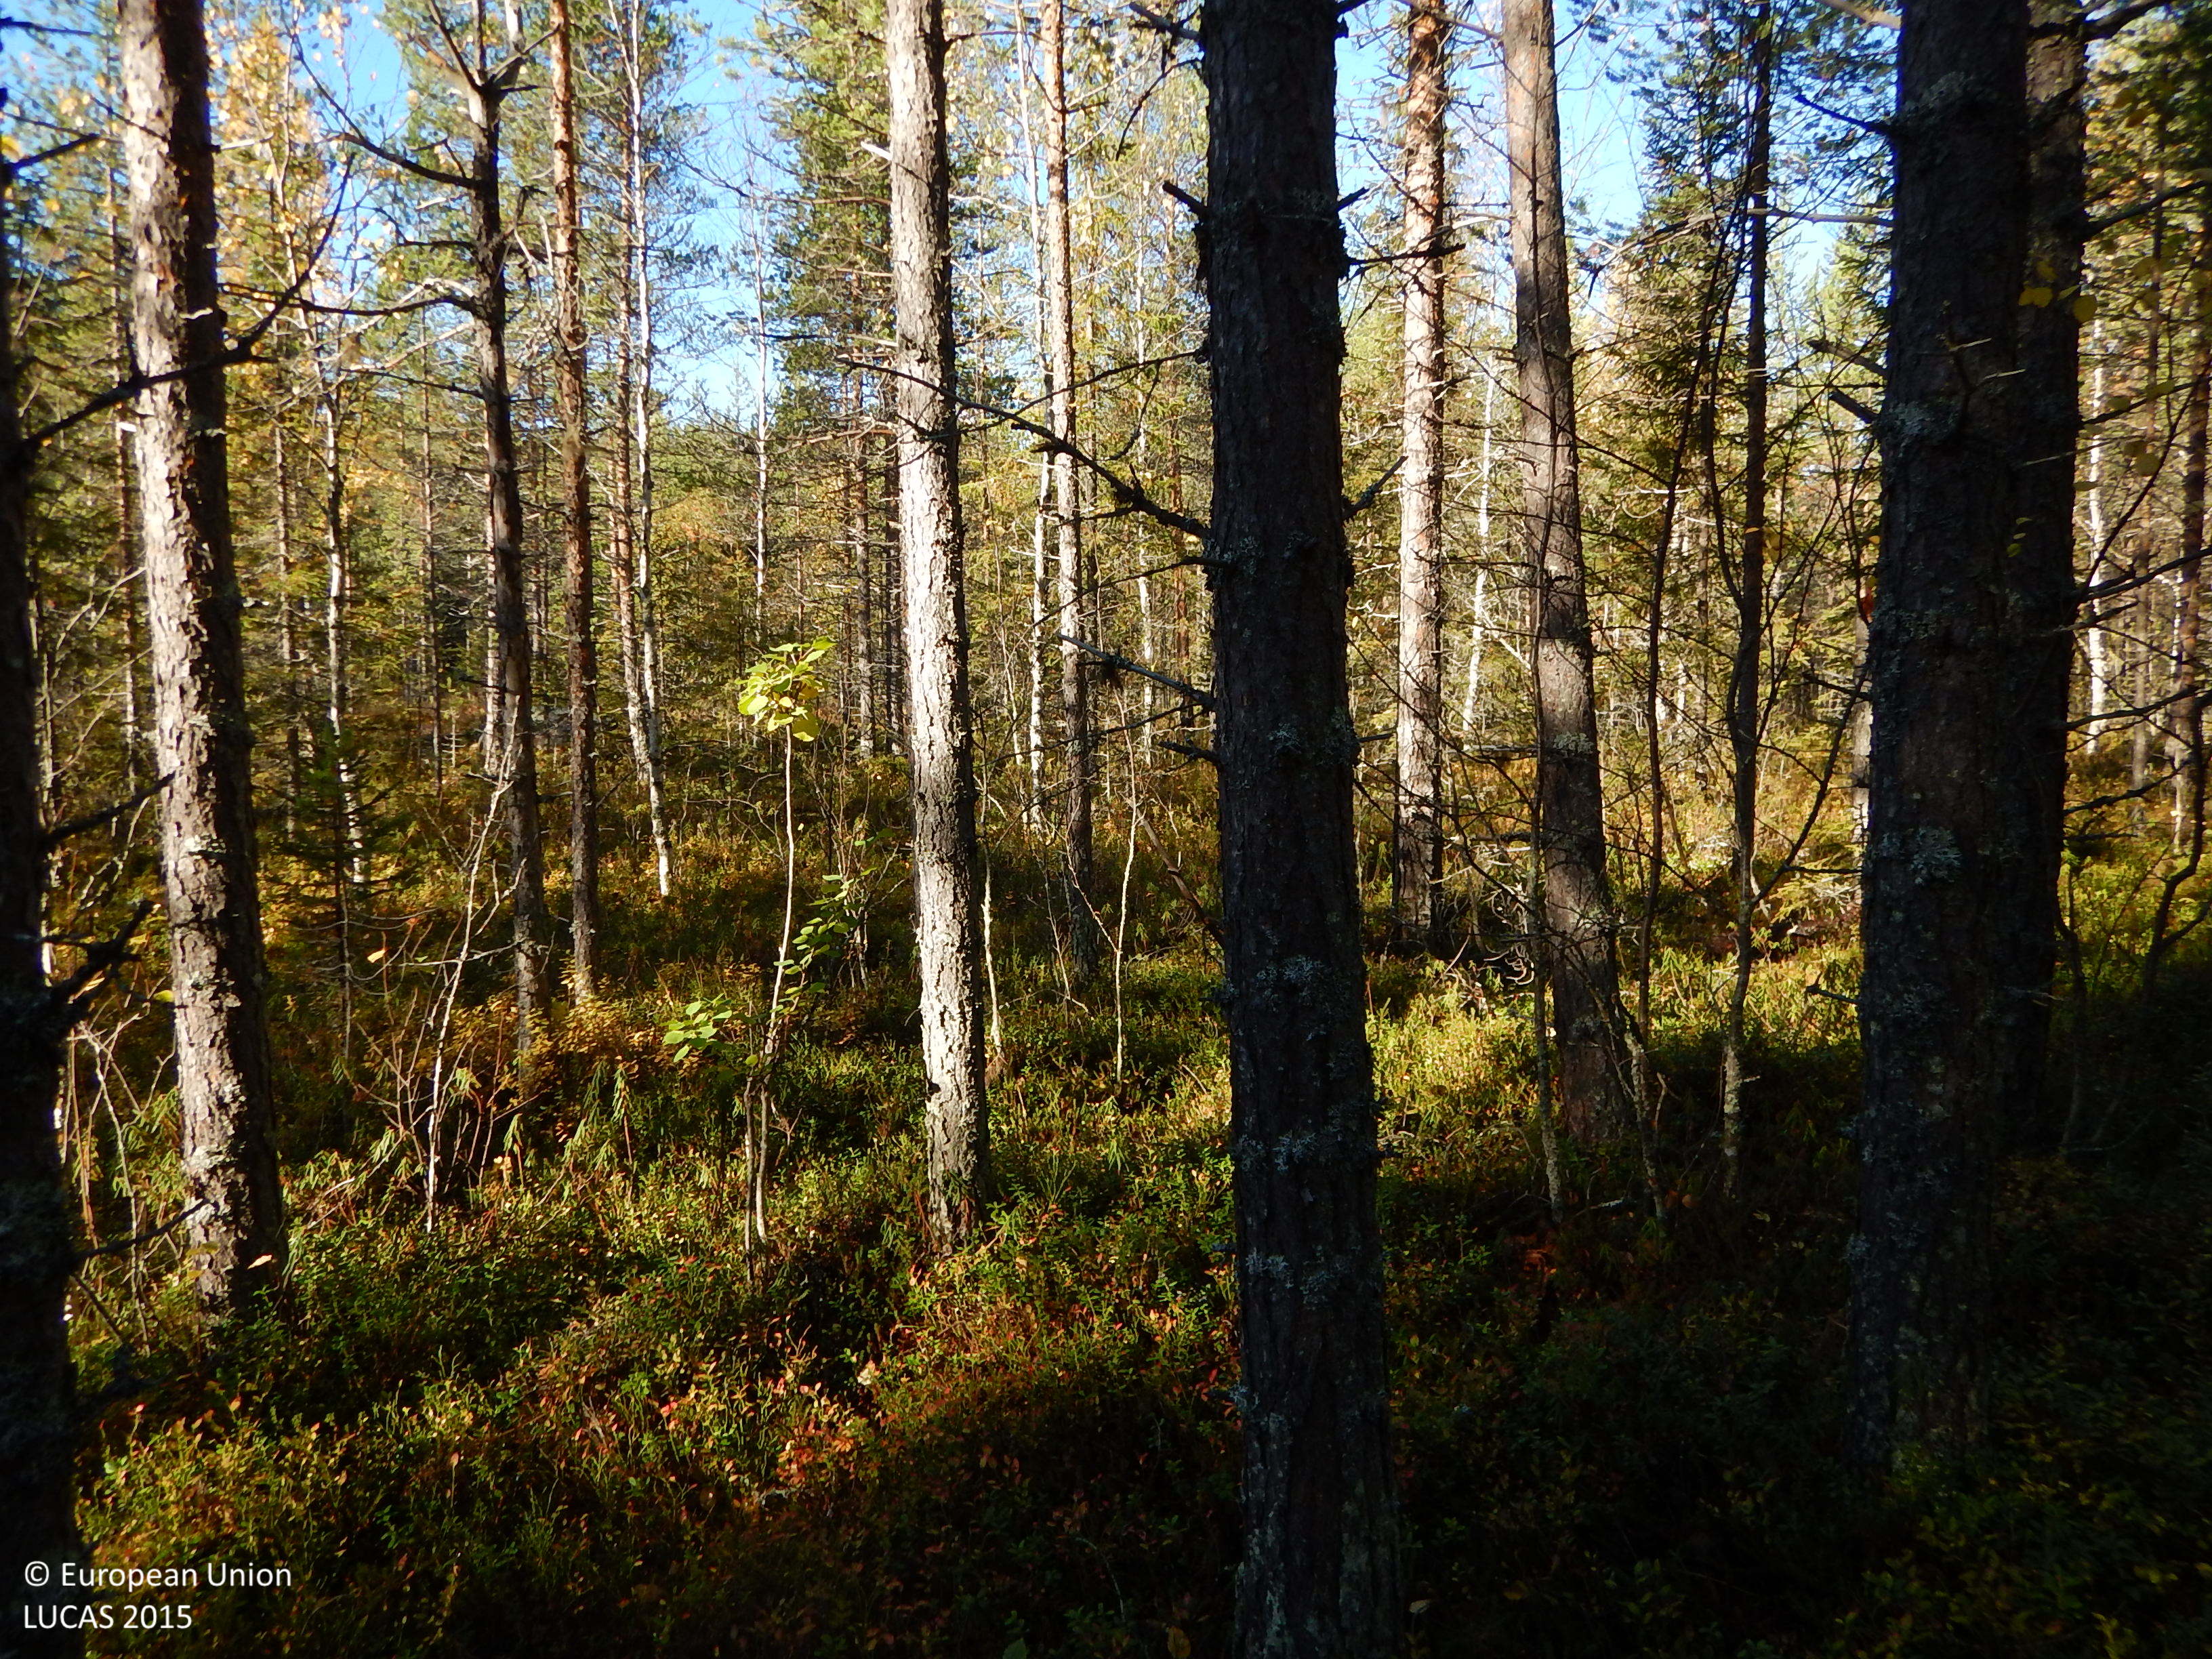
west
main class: Woodland
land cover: Pine dominated mixed woodland
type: boreal forest
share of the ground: 50 - 75 %
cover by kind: coniferous forest trees 40 %, lichens and mosses 20 %, broadleaved forest trees 15 %, shrubs 15 %, herbaceous plants 10 %
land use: Forestry
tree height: > 5 m
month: September
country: SE
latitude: 64.8893
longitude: 19.9172
